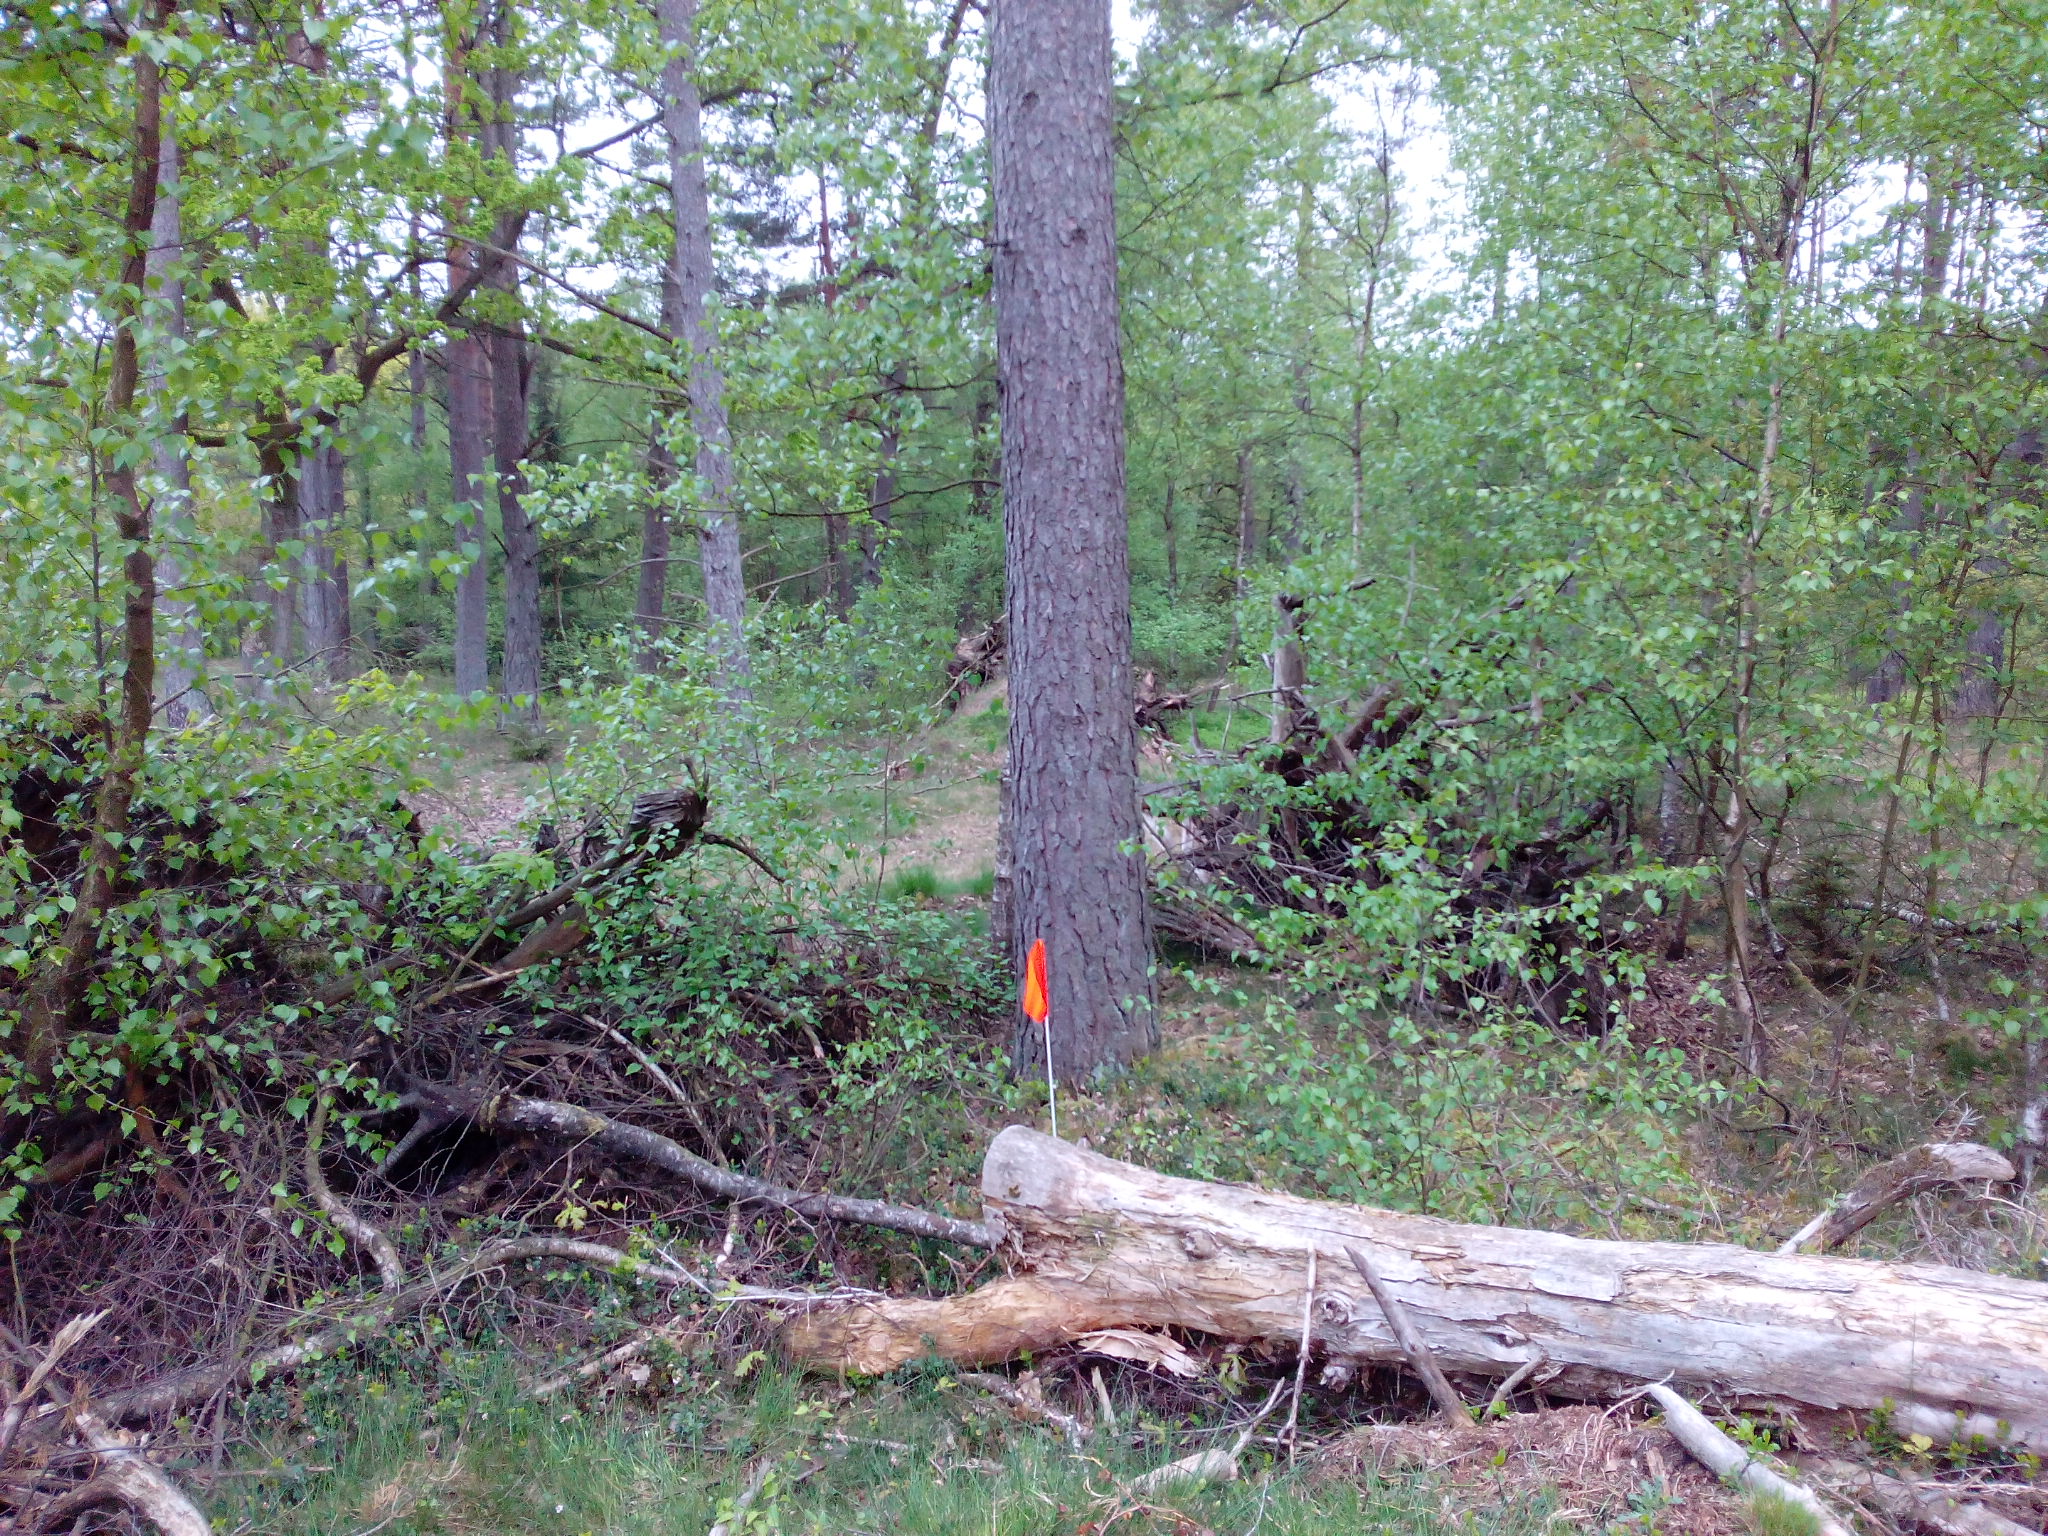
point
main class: Woodland
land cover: Pine dominated mixed woodland
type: hemiboreal forest and nemoral coniferous forest and mixed broadleaved-coniferous forest
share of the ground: 50 - 75 %
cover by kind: coniferous forest trees 60 %, broadleaved forest trees 30 %, herbaceous plants 10 %
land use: Forestry
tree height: > 5 m
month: May
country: DE
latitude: 52.9706
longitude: 9.9256
